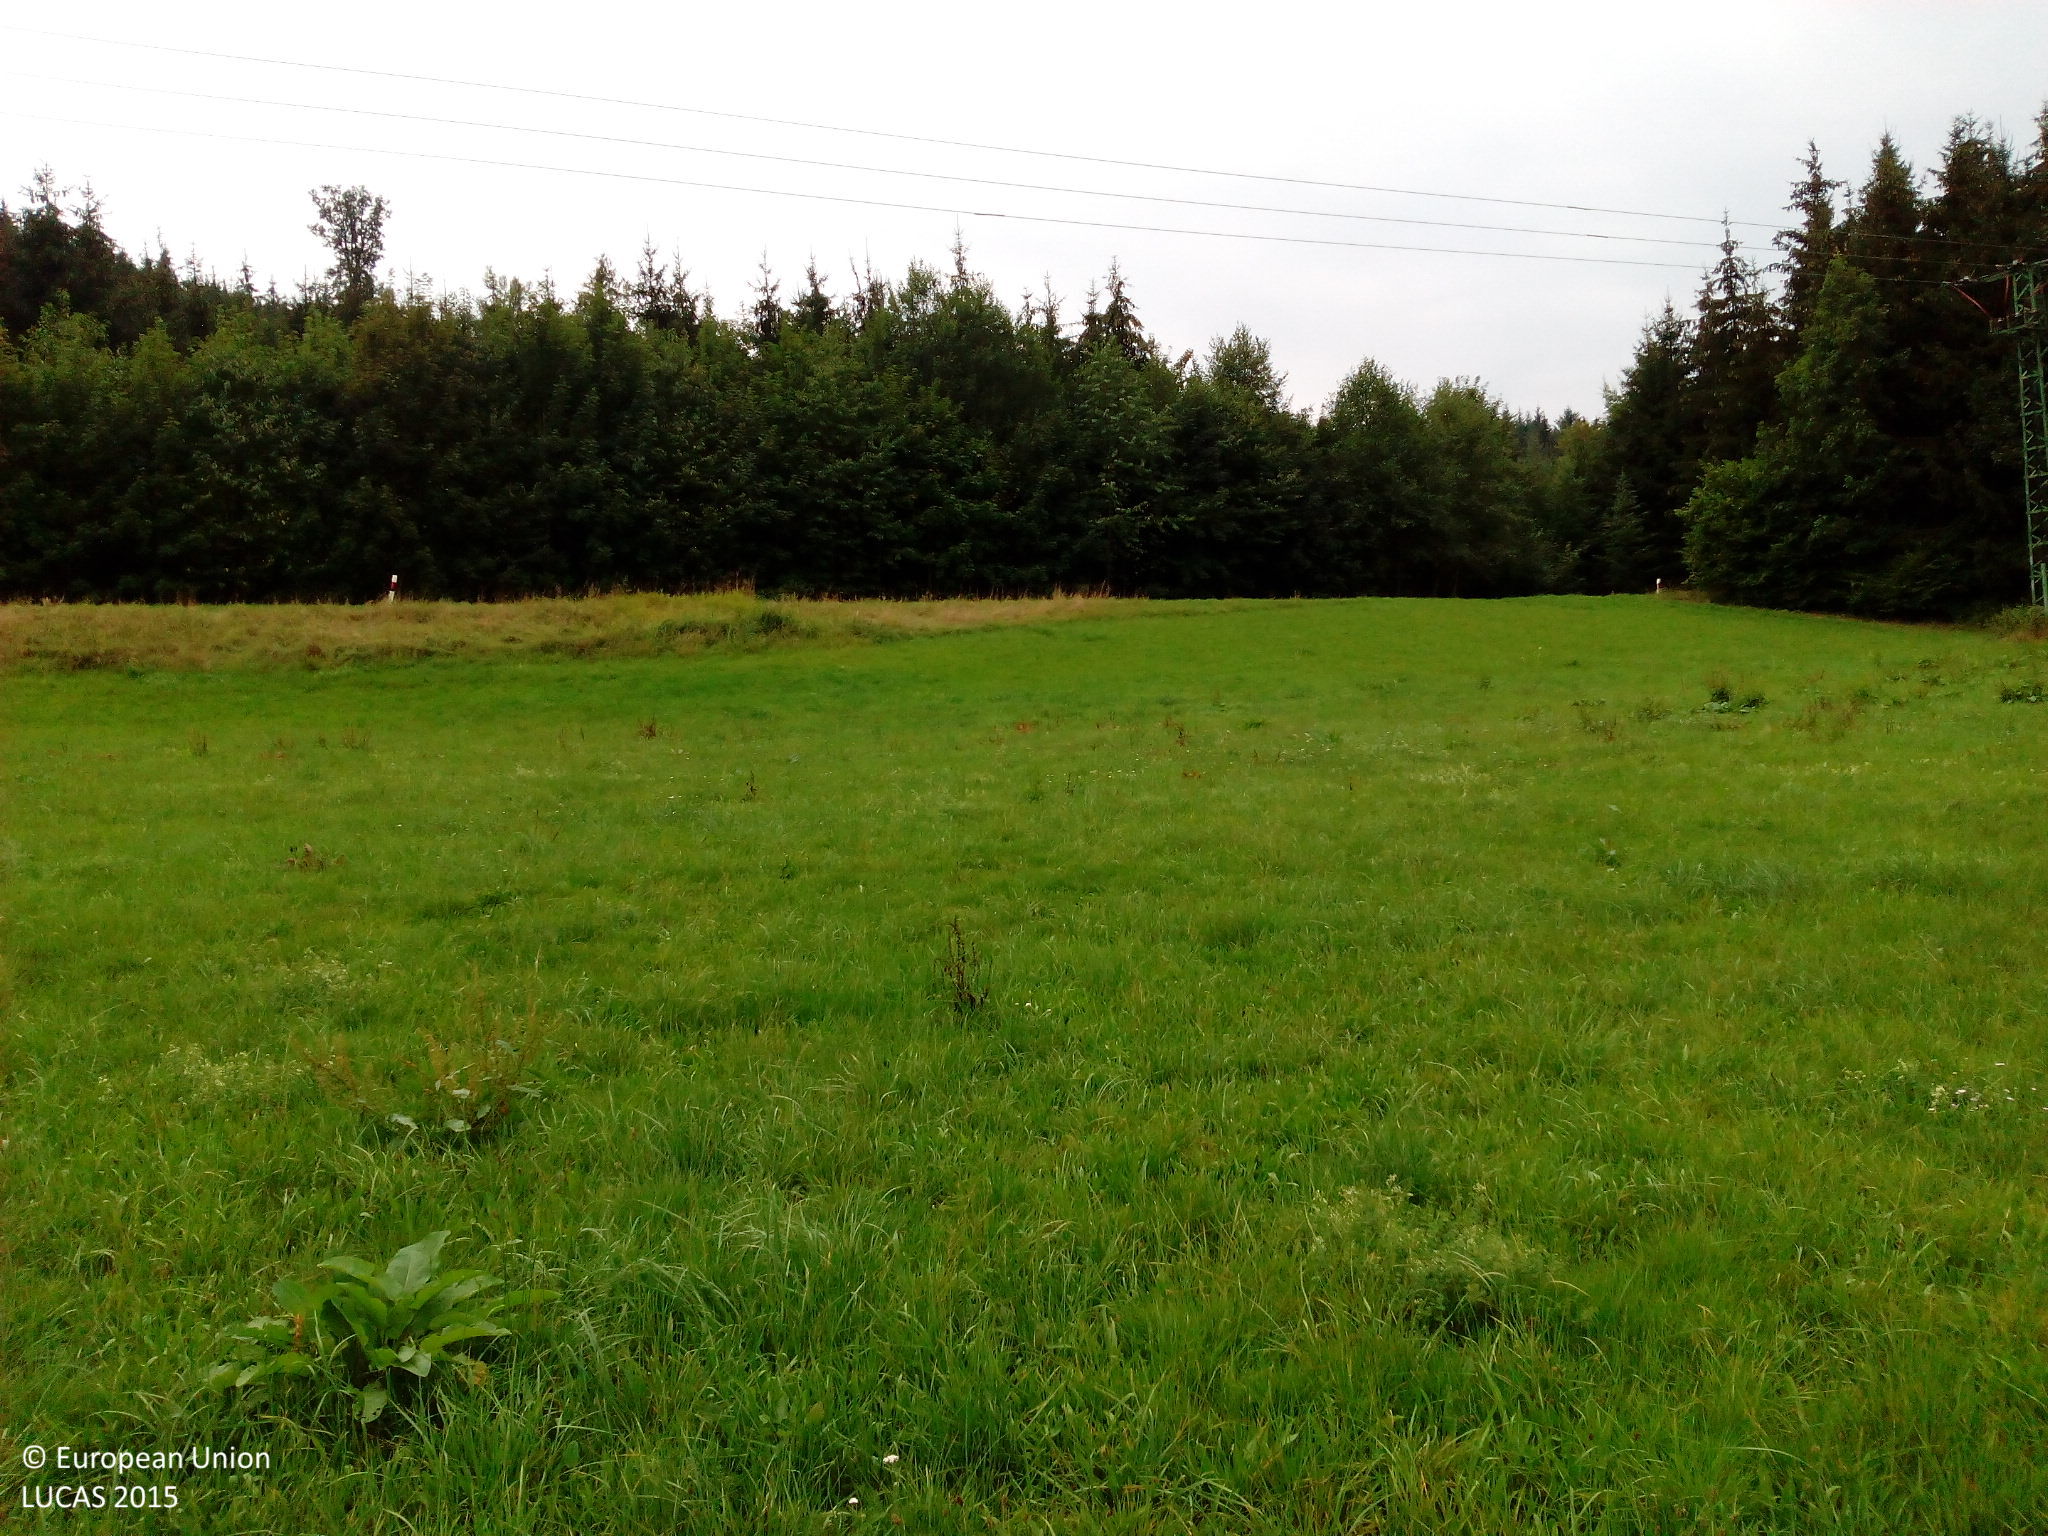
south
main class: Grassland
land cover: Grassland without tree/shrub cover
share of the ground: > 75 %
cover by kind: herbaceous plants 100 %
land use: Agriculture (excluding fallow land and kitchen gardens)
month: September
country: DE
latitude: 48.3482
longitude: 10.5259
